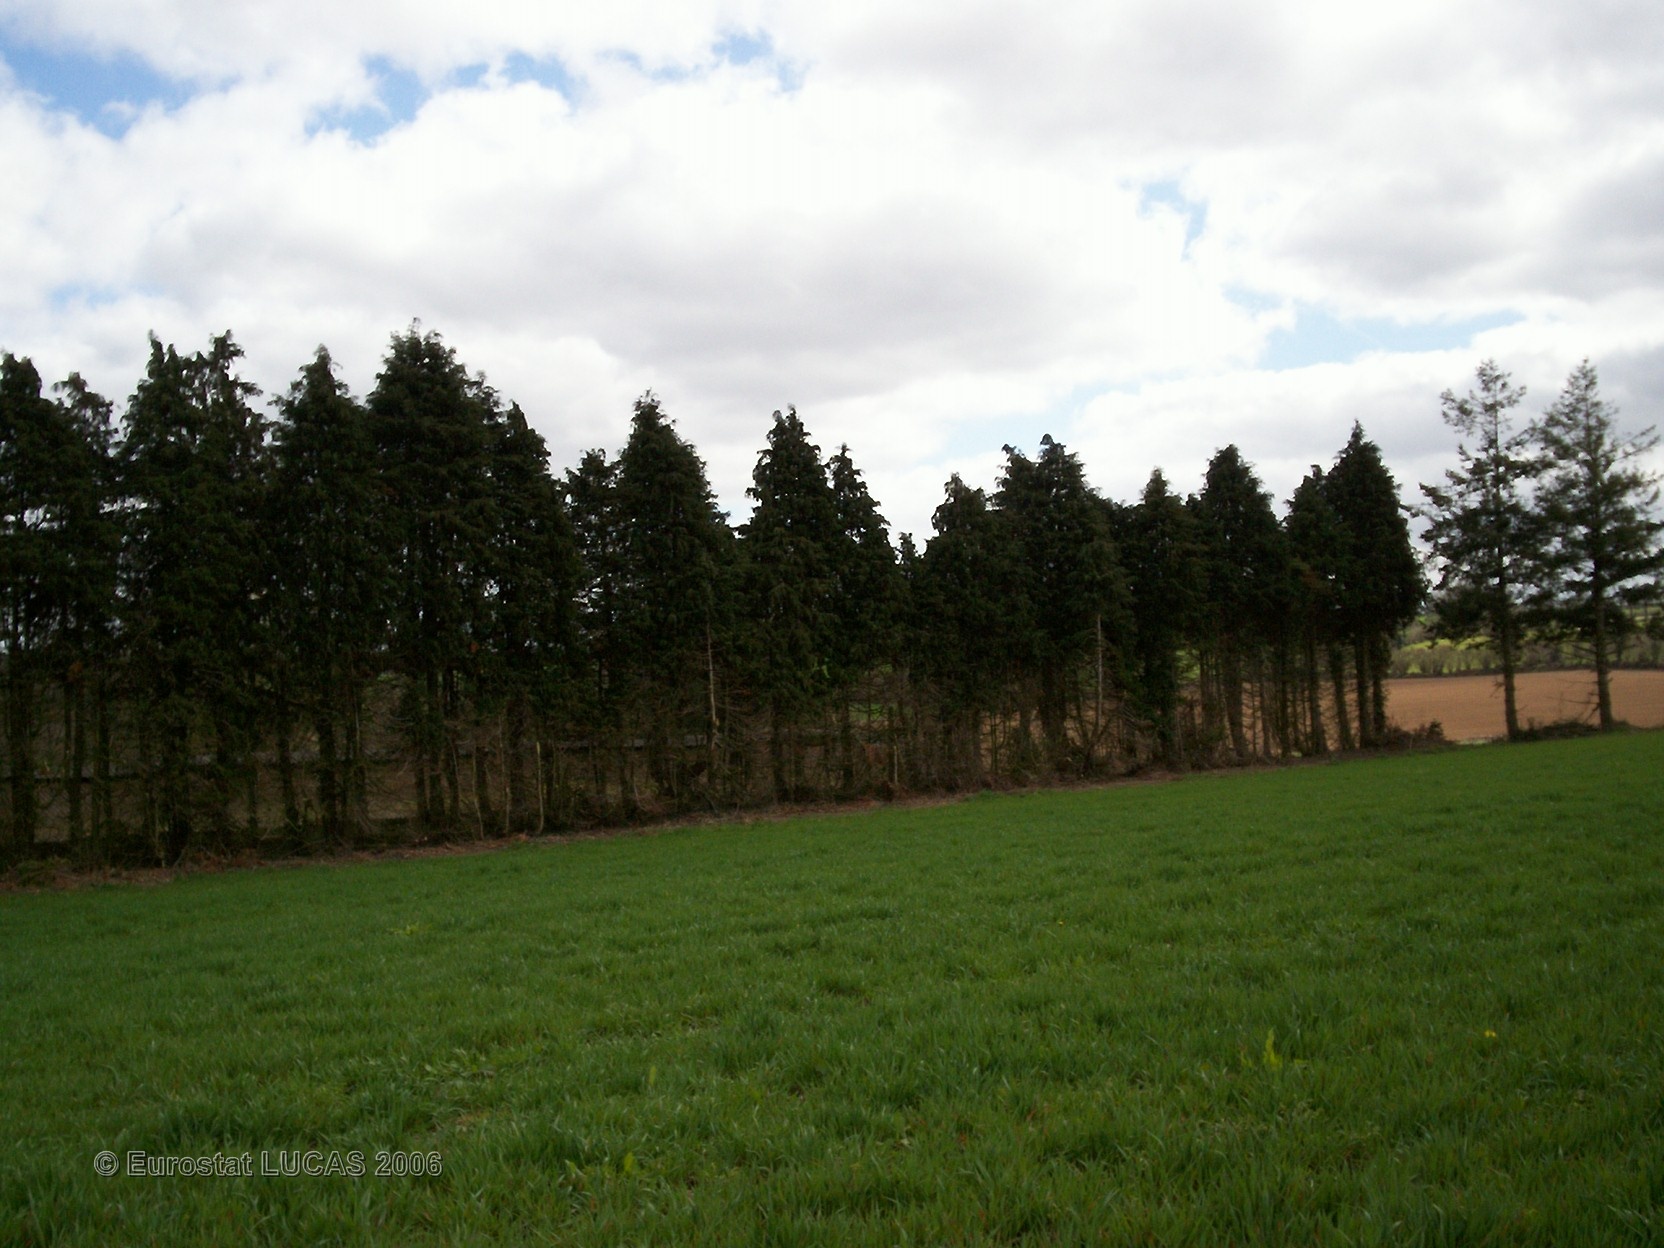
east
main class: Cropland
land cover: Oats
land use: Agriculture (excluding fallow land and kitchen gardens)
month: April
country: FR
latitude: 48.2321
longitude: -3.6101
